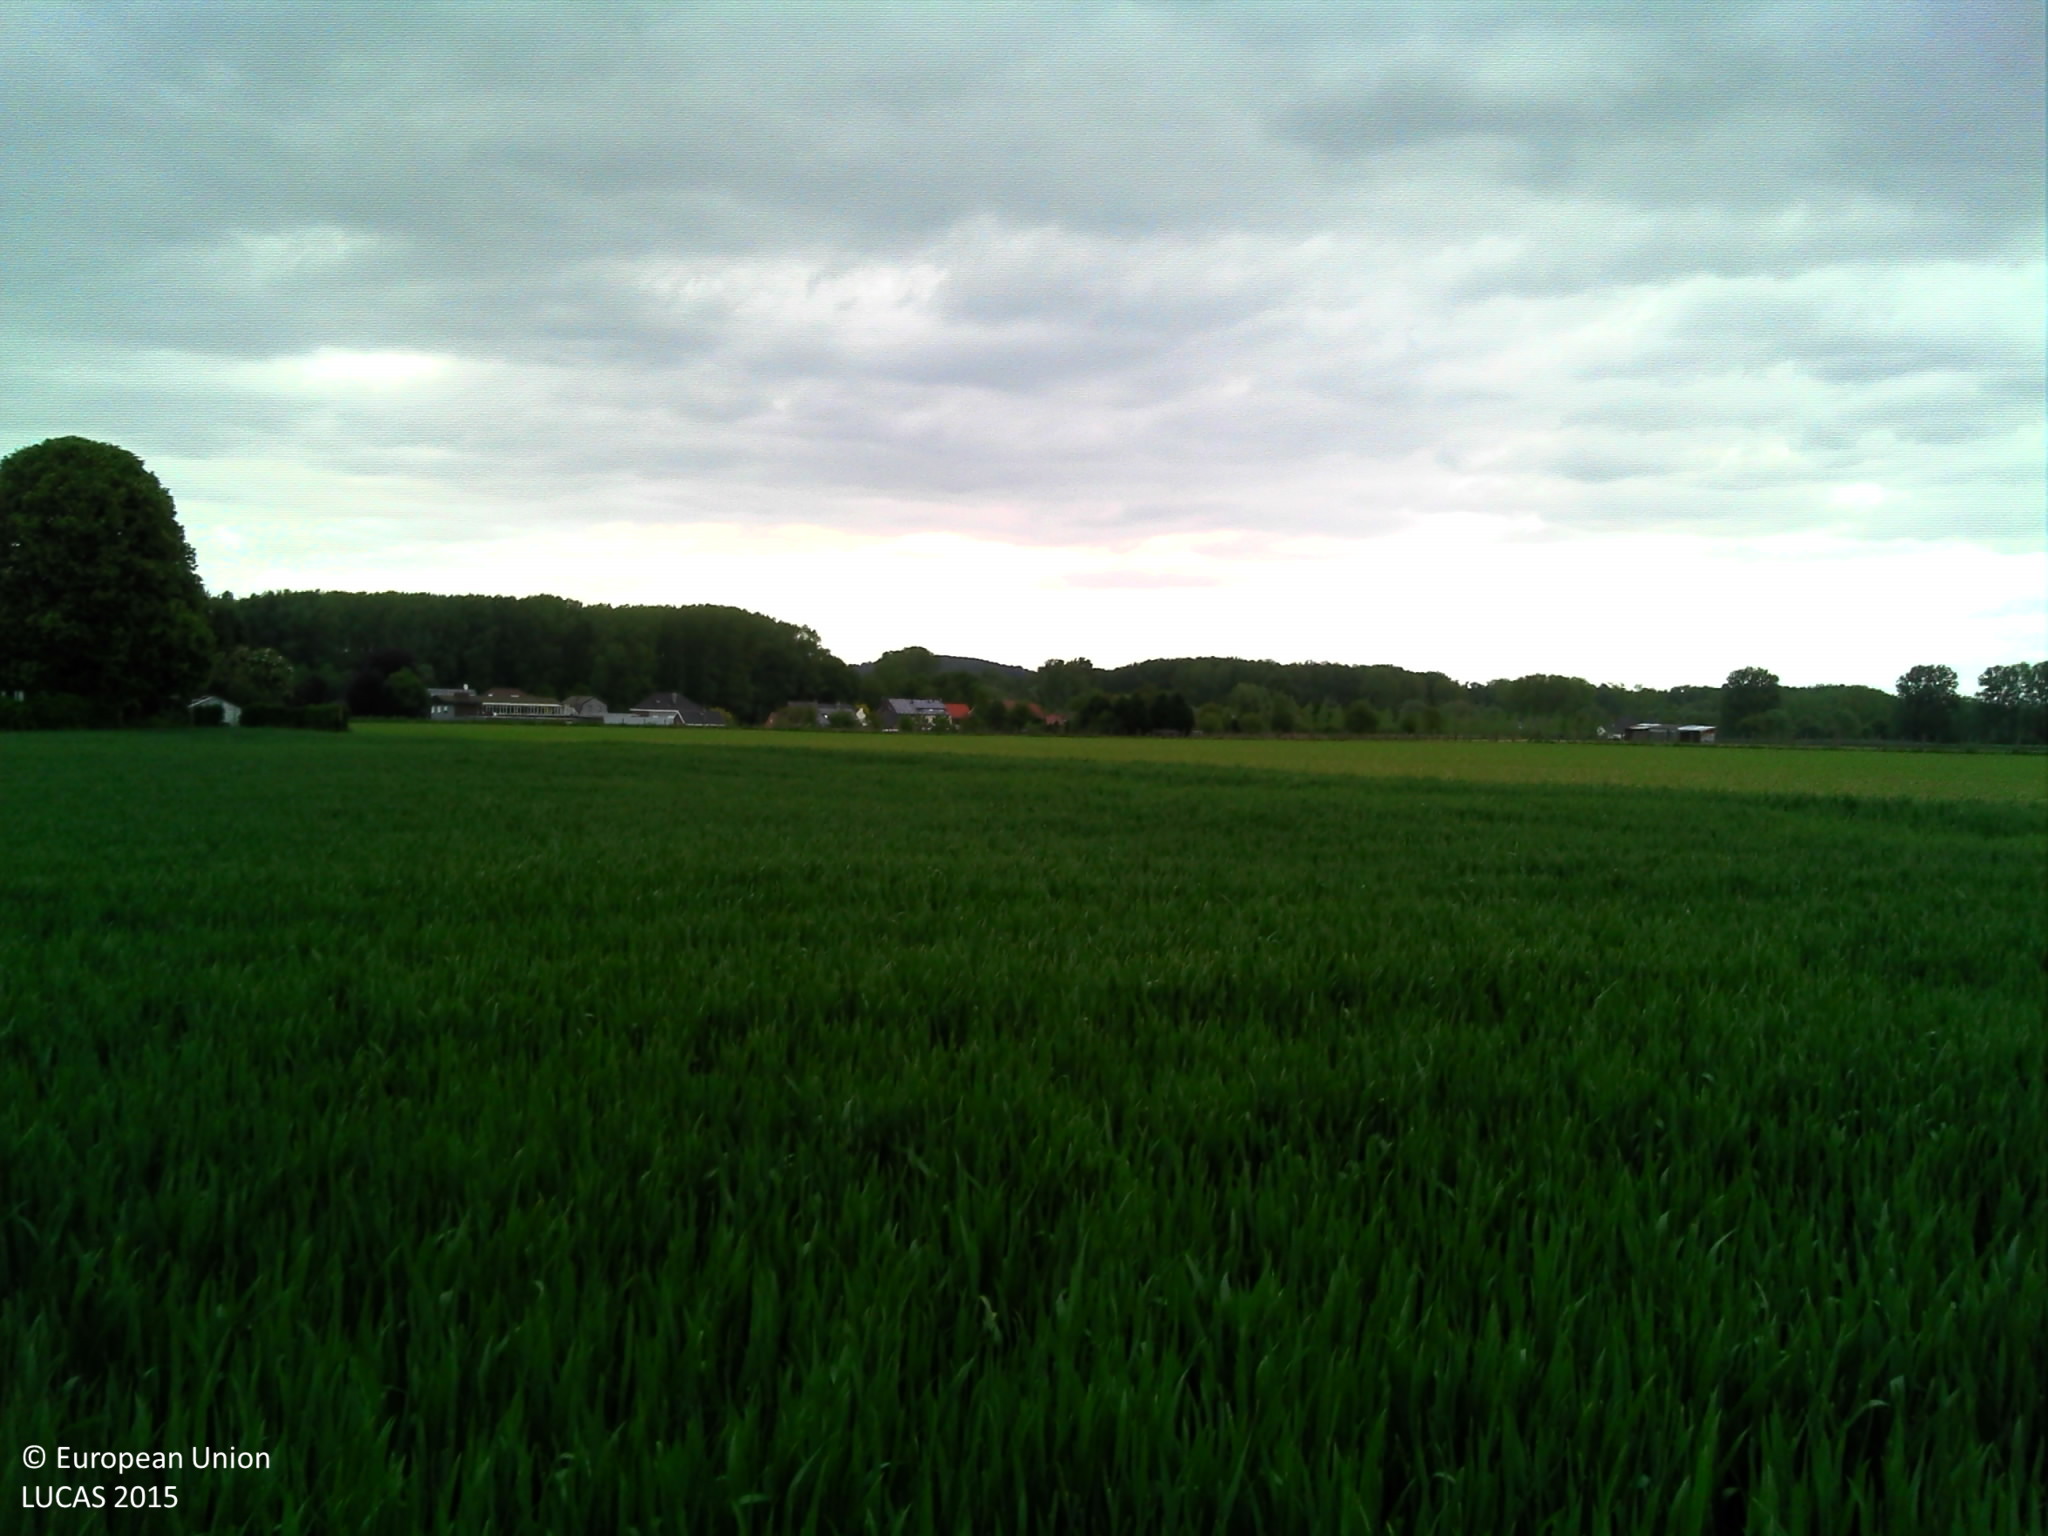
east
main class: Grassland
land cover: Grassland without tree/shrub cover
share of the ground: > 75 %
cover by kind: herbaceous plants 95 %, shrubs 5 %
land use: Residential
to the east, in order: Grassland without tree/shrub cover; Managed hedges; Common wheat; Maize; Fences; Grassland without tree/shrub cover; Fences; Grassland without tree/shrub cover; Fences
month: May
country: BE
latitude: 50.7460
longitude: 3.9708
